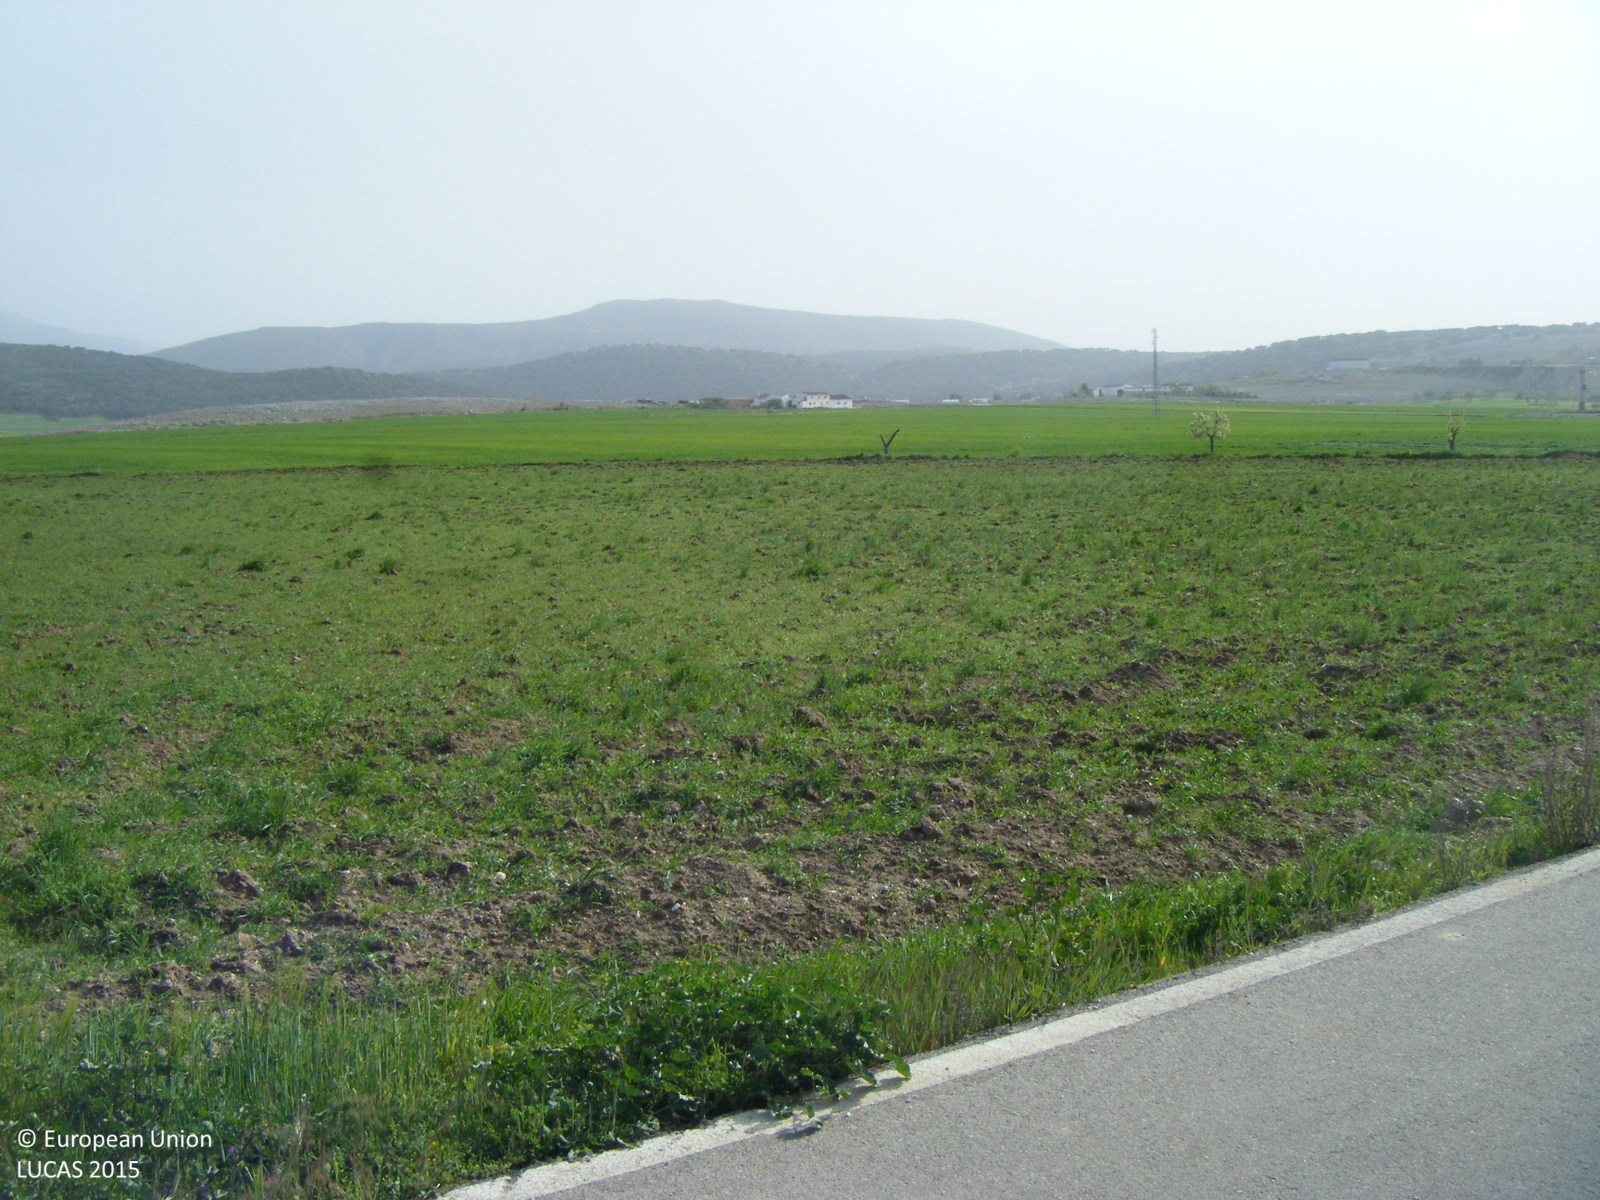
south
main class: Shrubland
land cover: Shrubland without tree cover
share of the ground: 50 - 75 %
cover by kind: shrubs 50 %, herbaceous plants 30 %, consolidated bare surface 20 %
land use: Agriculture (excluding fallow land and kitchen gardens)
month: April
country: ES
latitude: 37.0290
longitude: -4.0541
